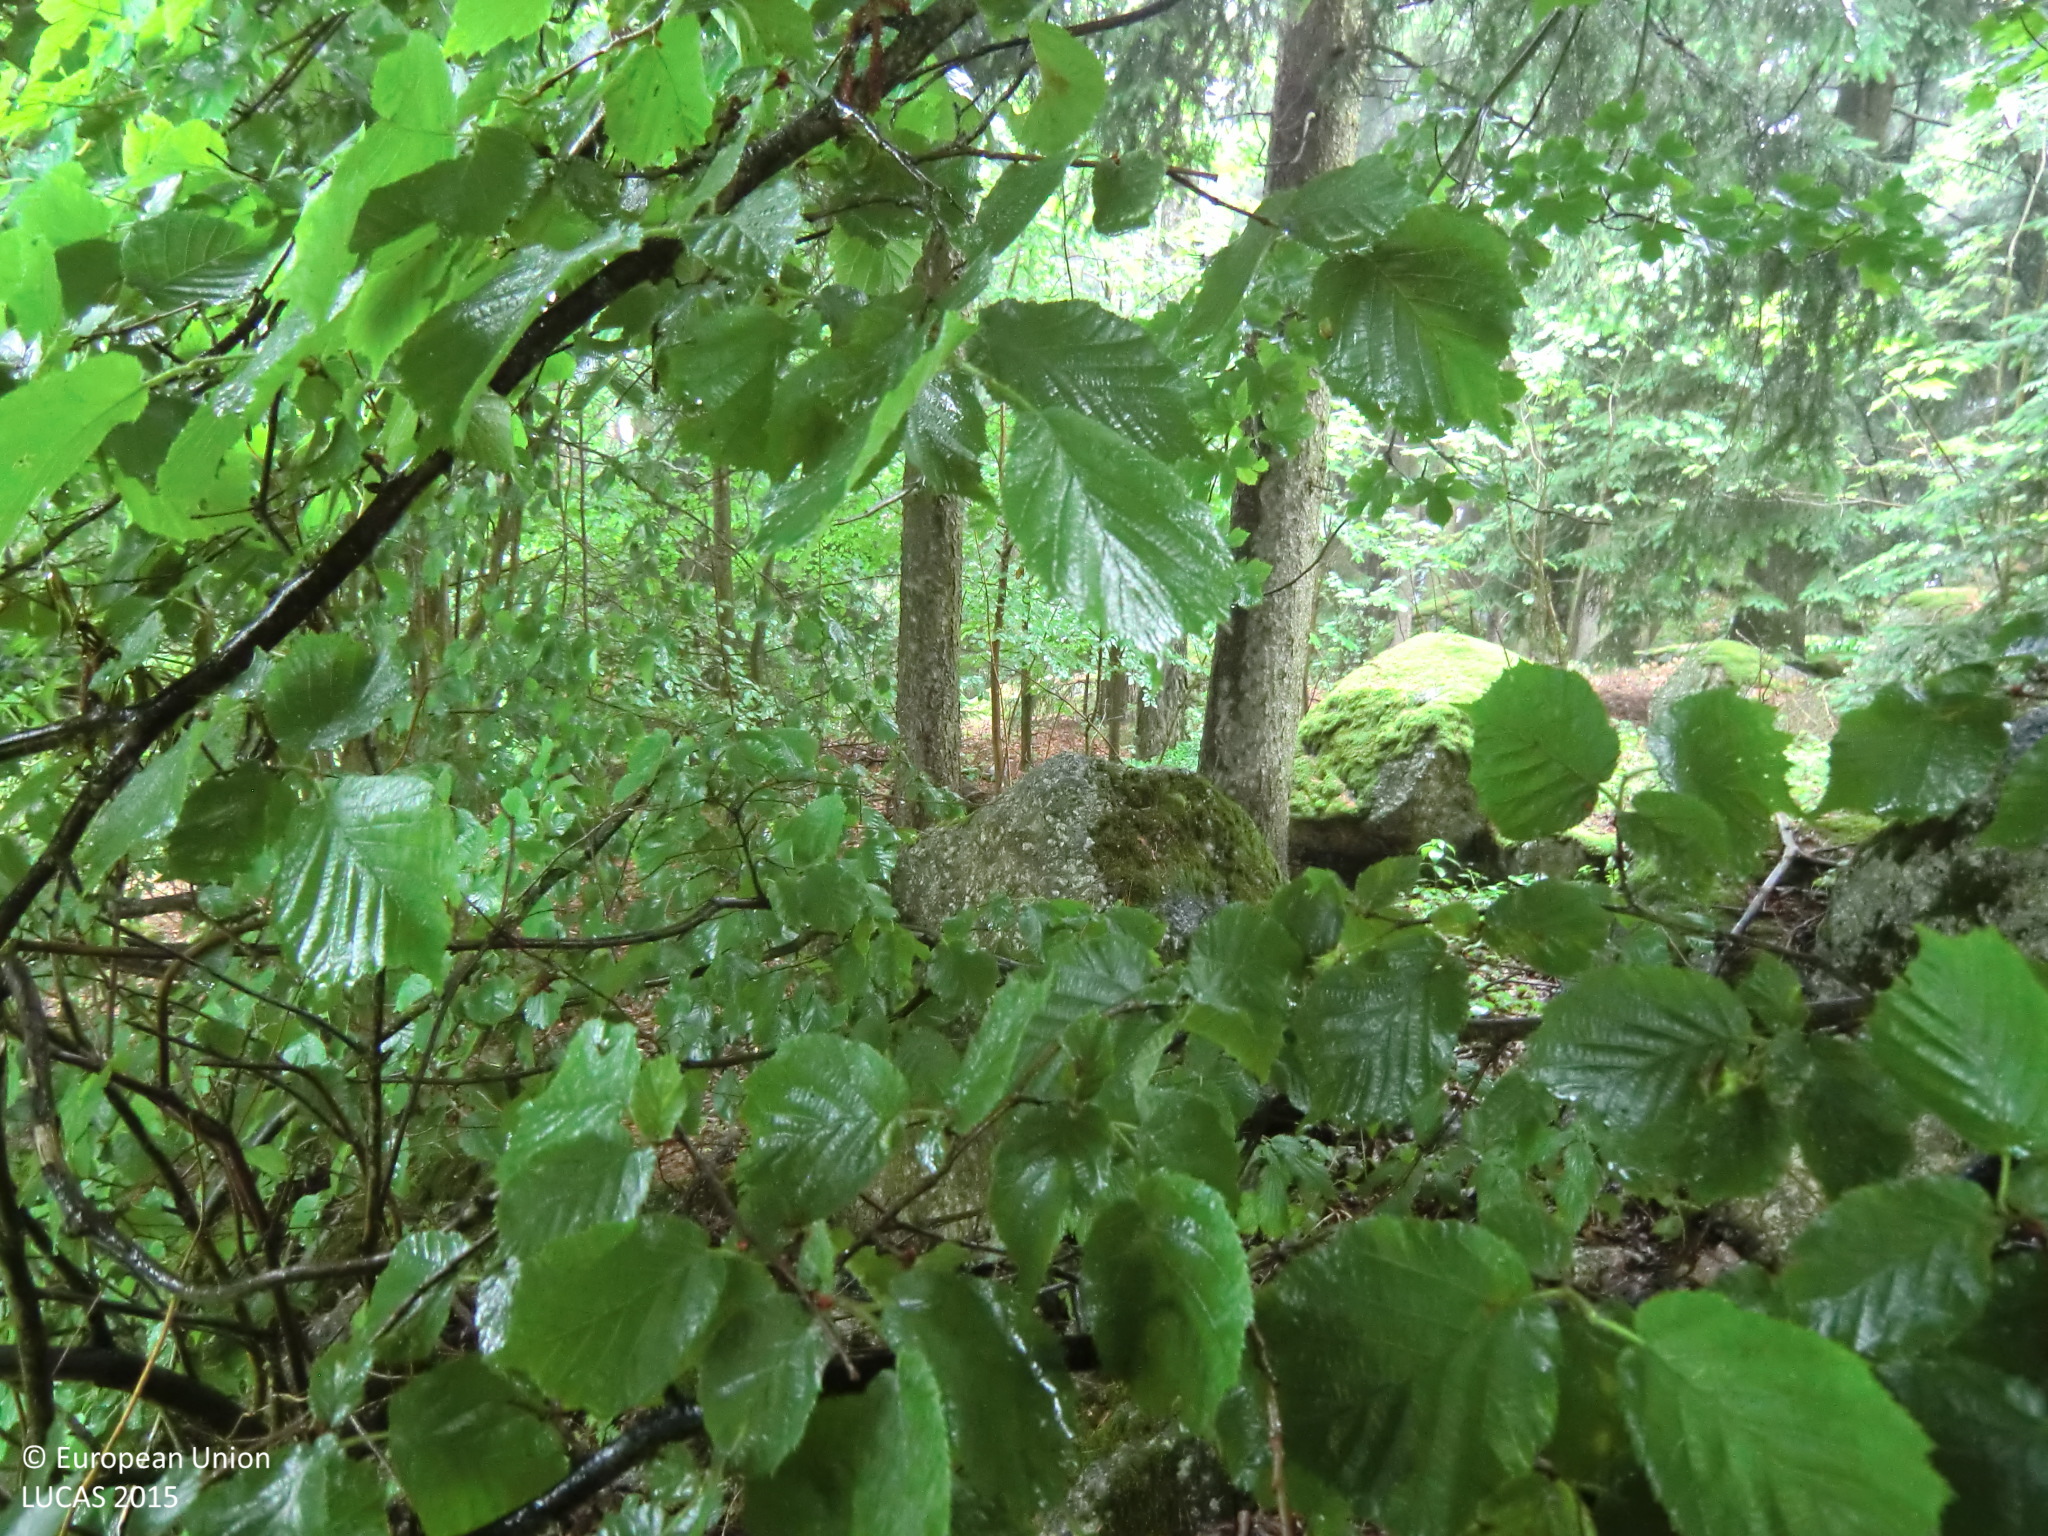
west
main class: Woodland
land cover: Spruce dominated mixed woodland
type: hemiboreal forest and nemoral coniferous forest and mixed broadleaved-coniferous forest
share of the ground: > 75 %
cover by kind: coniferous forest trees 45 %, broadleaved forest trees 40 %, shrubs 5 %, lichens and mosses 5 %, consolidated bare surface 5 %
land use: Forestry
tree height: > 5 m
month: June
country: AT
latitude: 48.4874
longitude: 14.6147
